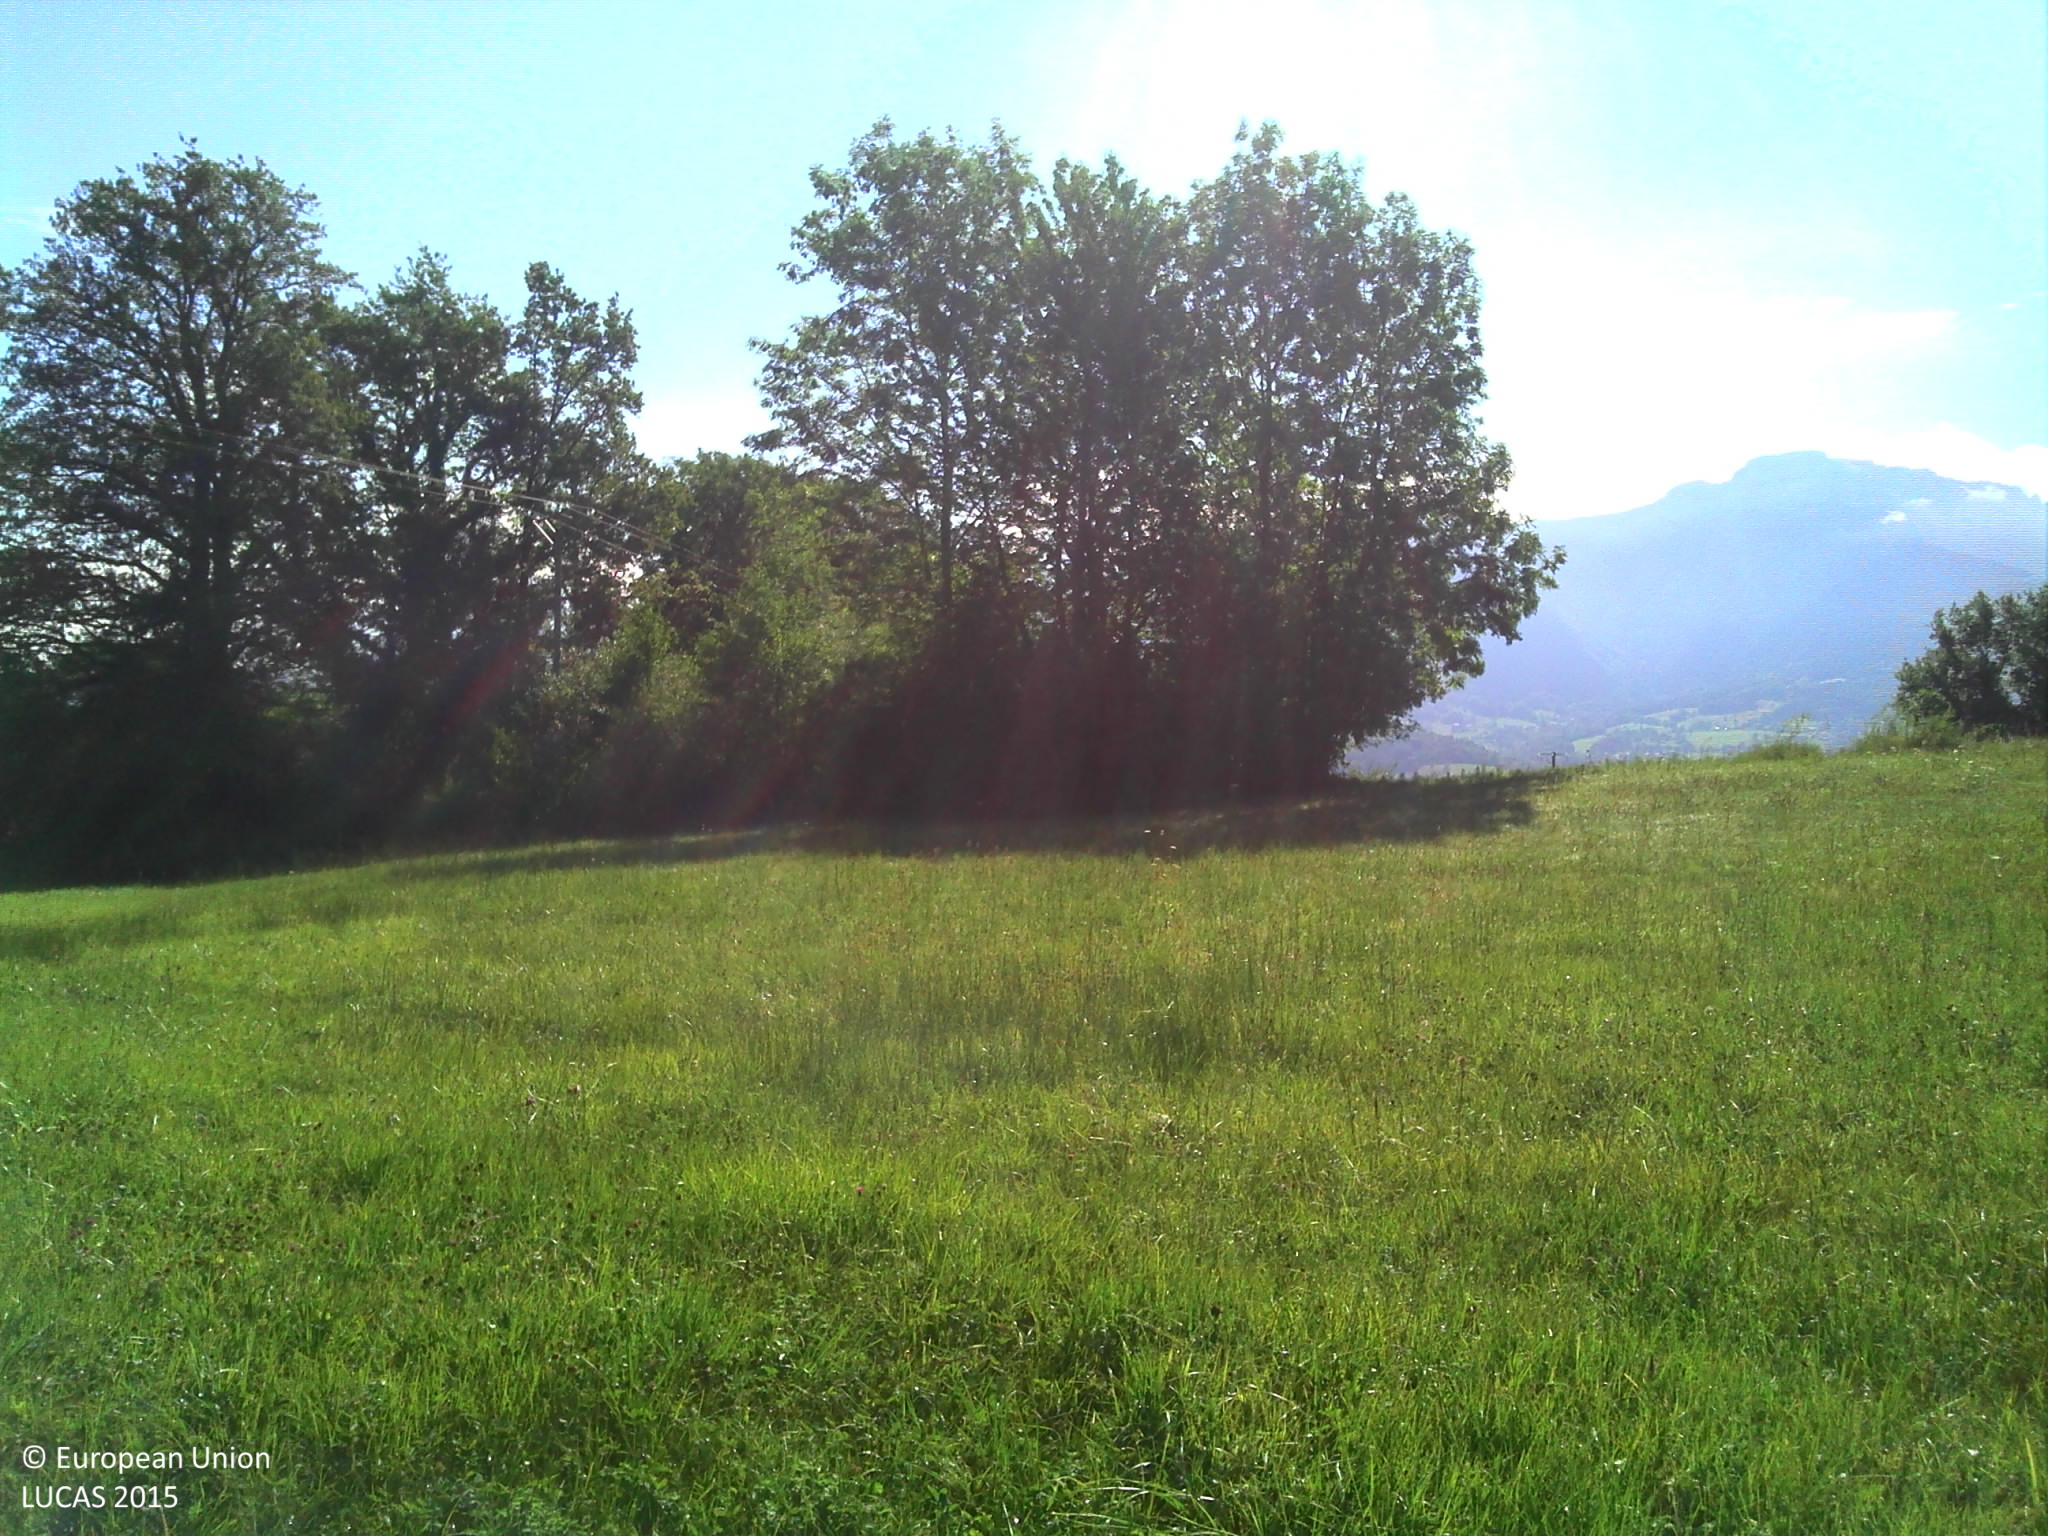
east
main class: Grassland
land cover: Grassland without tree/shrub cover
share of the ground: > 75 %
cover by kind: herbaceous plants 100 %
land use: Agriculture (excluding fallow land and kitchen gardens)
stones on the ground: < 10 %
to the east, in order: Grassland without tree/shrub cover; Broadleaved woodland; Grassland without tree/shrub cover; Electric lines; Grassland without tree/shrub cover; Rivers and streams; Managed hedges; Rivers and streams; Broadleaved woodland; Grassland without tree/shrub cover; Broadleaved woodland; Fences; Broadleaved woodland; Managed hedges; Grassland without tree/shrub cover
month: July
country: FR
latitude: 45.9752
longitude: 6.1448
